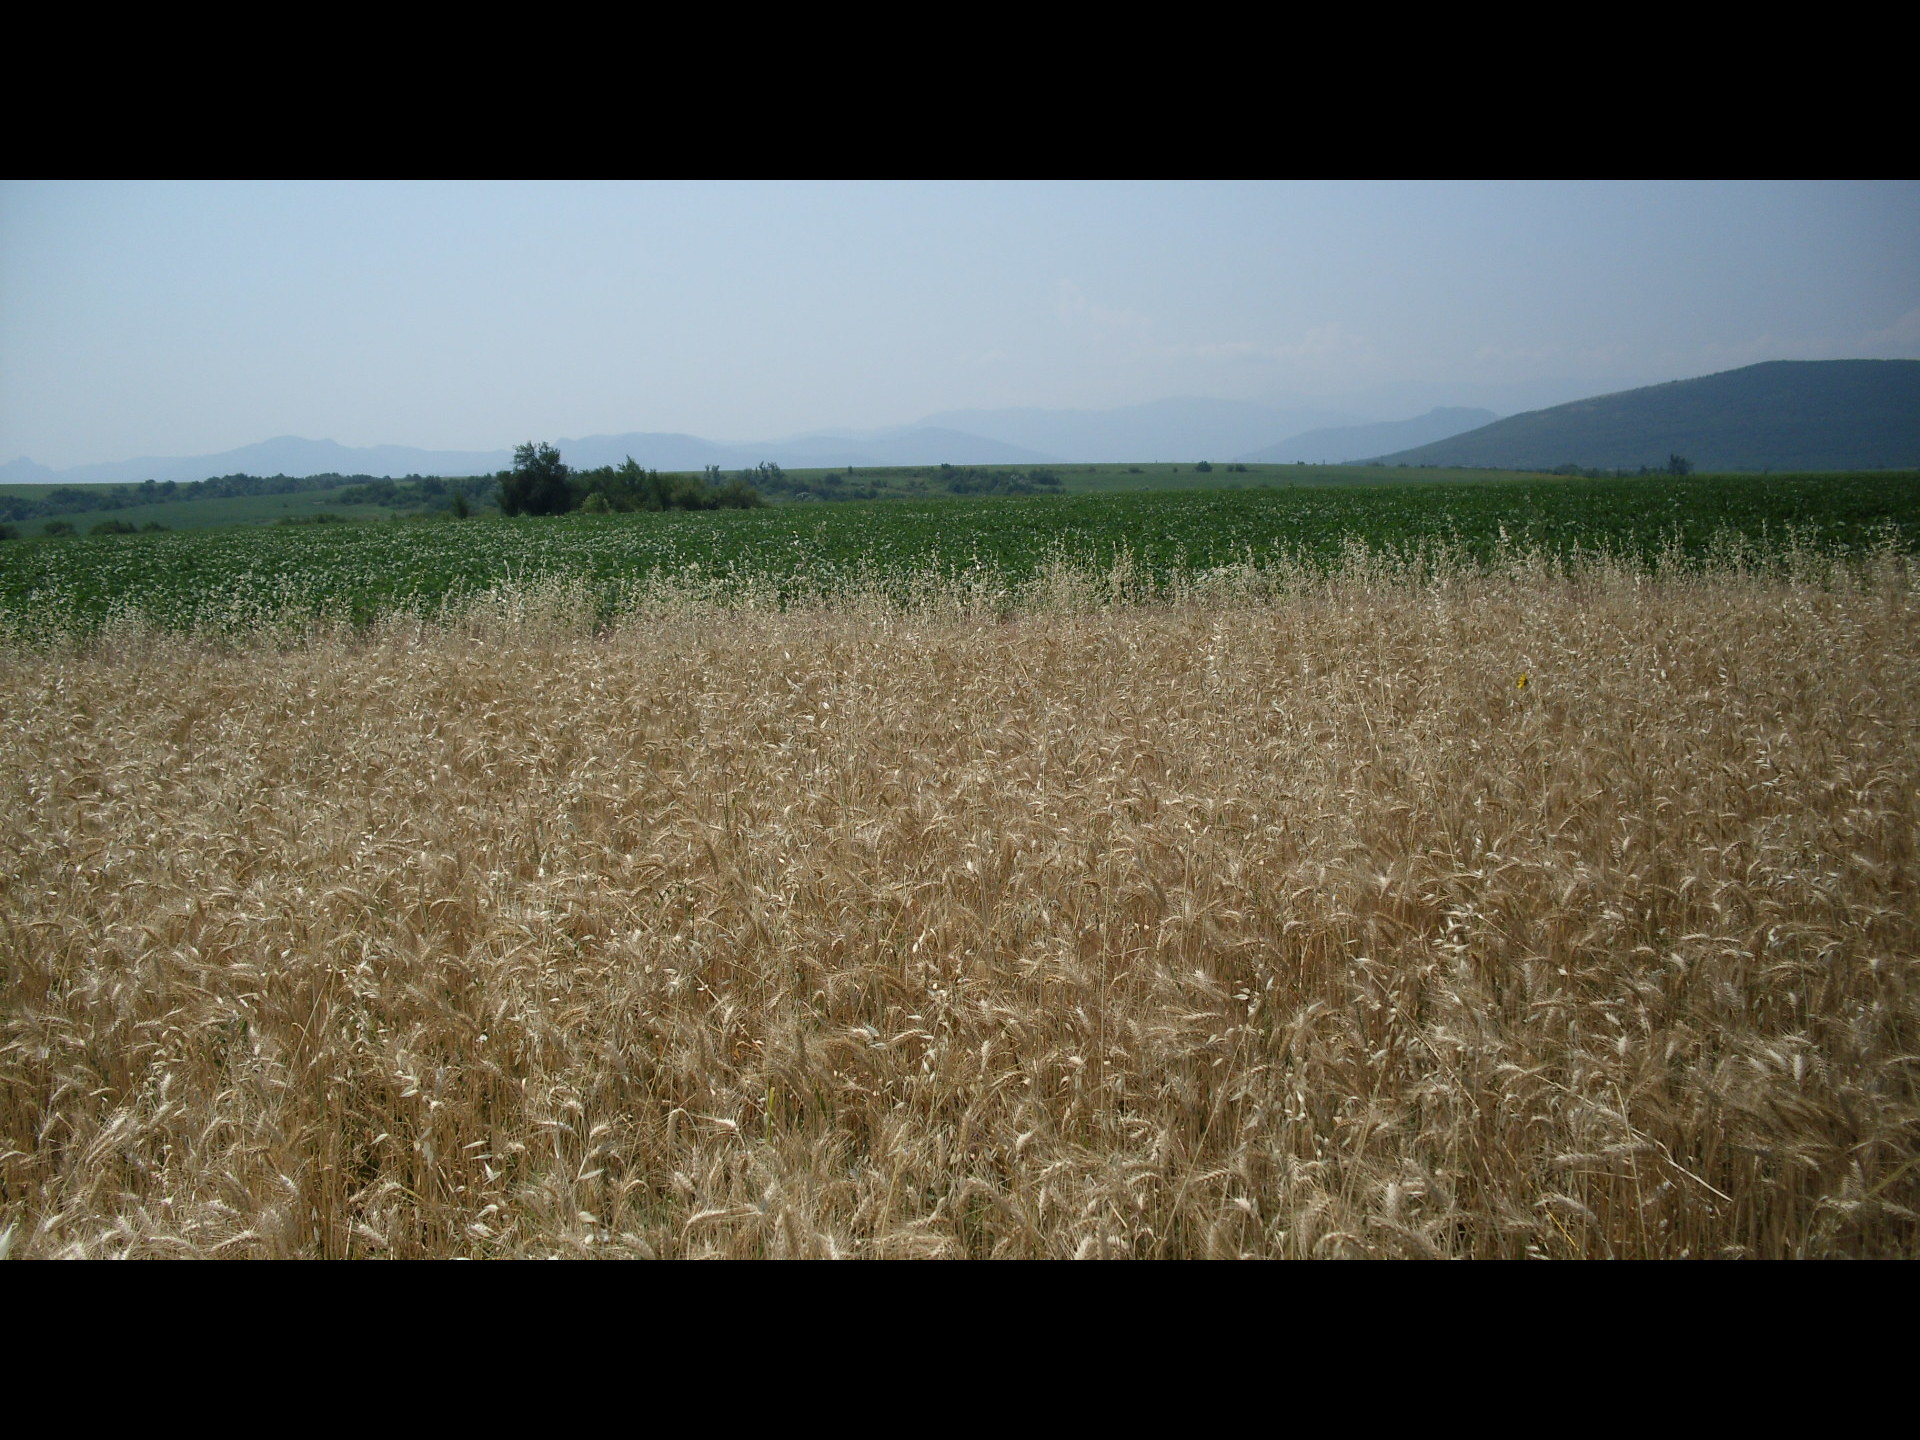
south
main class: Cropland
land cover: Common wheat
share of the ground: > 75 %
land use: Agriculture (excluding fallow land and kitchen gardens)
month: July
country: BG
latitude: 43.6494
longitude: 22.7681
